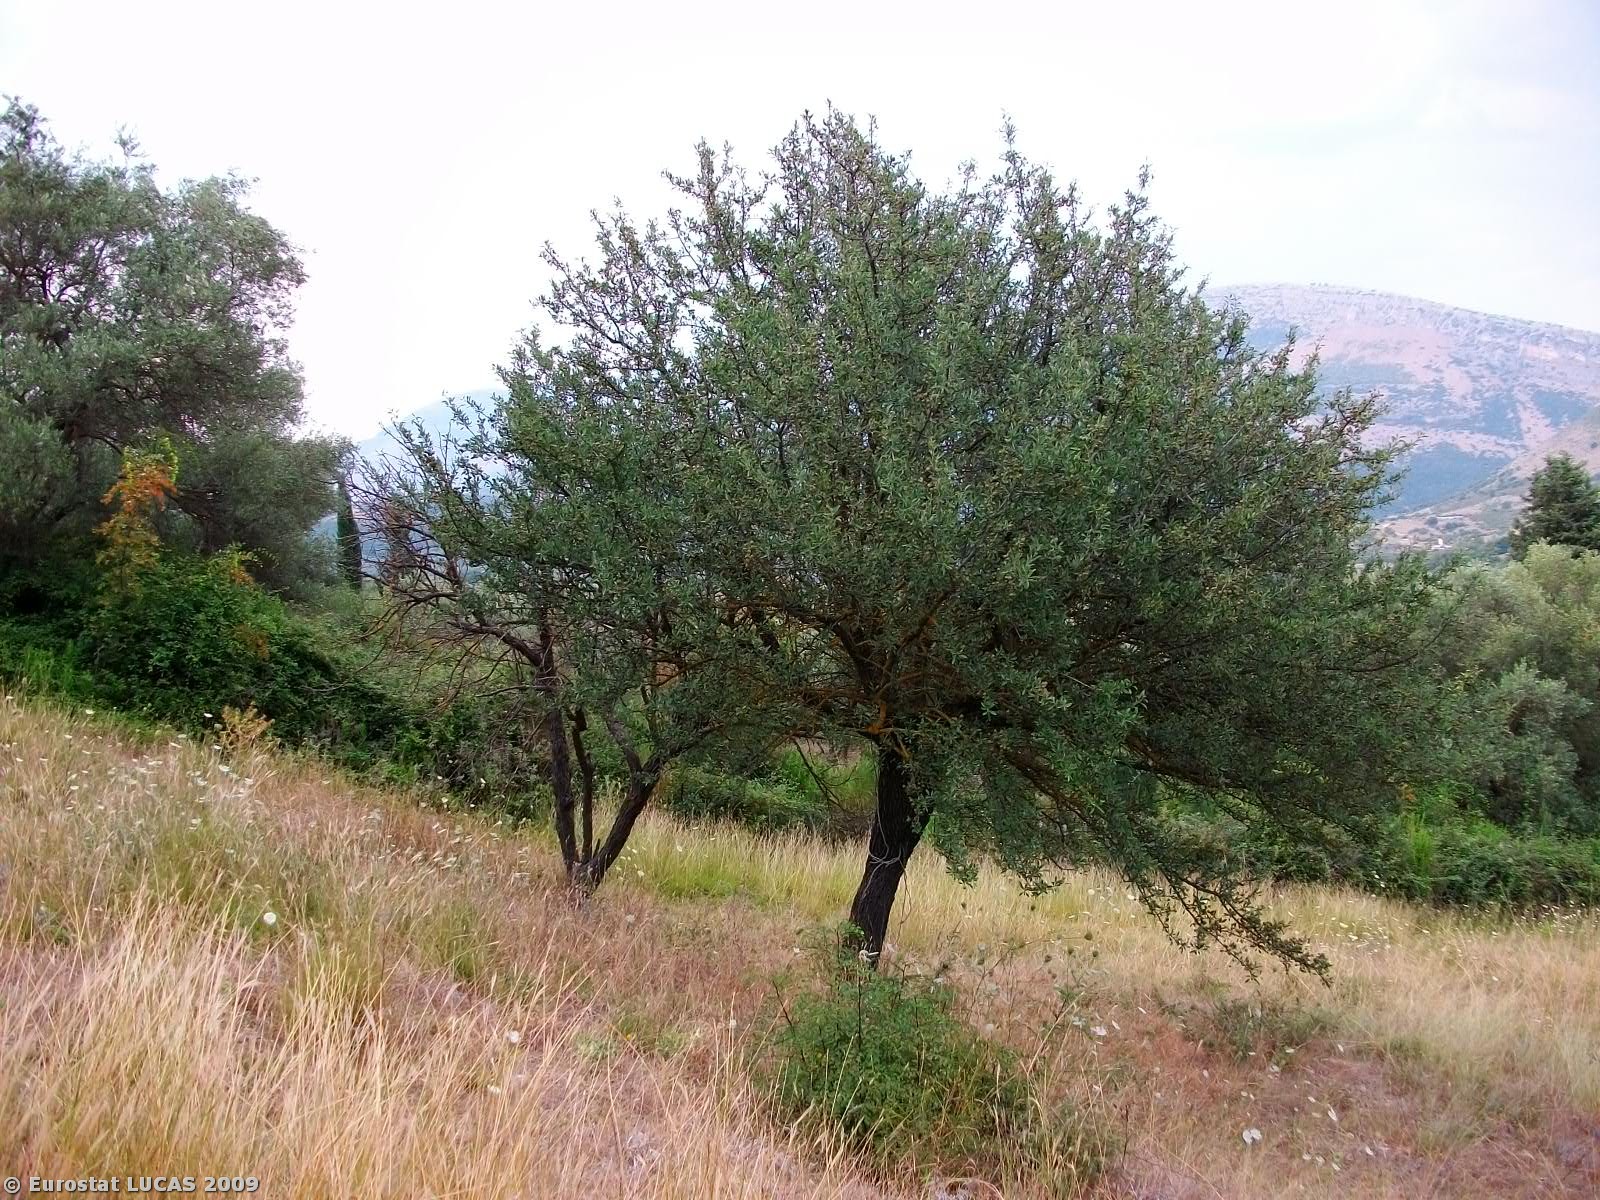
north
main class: Cropland
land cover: Olive groves
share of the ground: < 10 %
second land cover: Grassland with sparse tree/shrub cover
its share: > 75 %
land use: Agriculture (excluding fallow land and kitchen gardens)
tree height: < 5 m
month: August
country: GR
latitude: 39.5574
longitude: 20.3213
